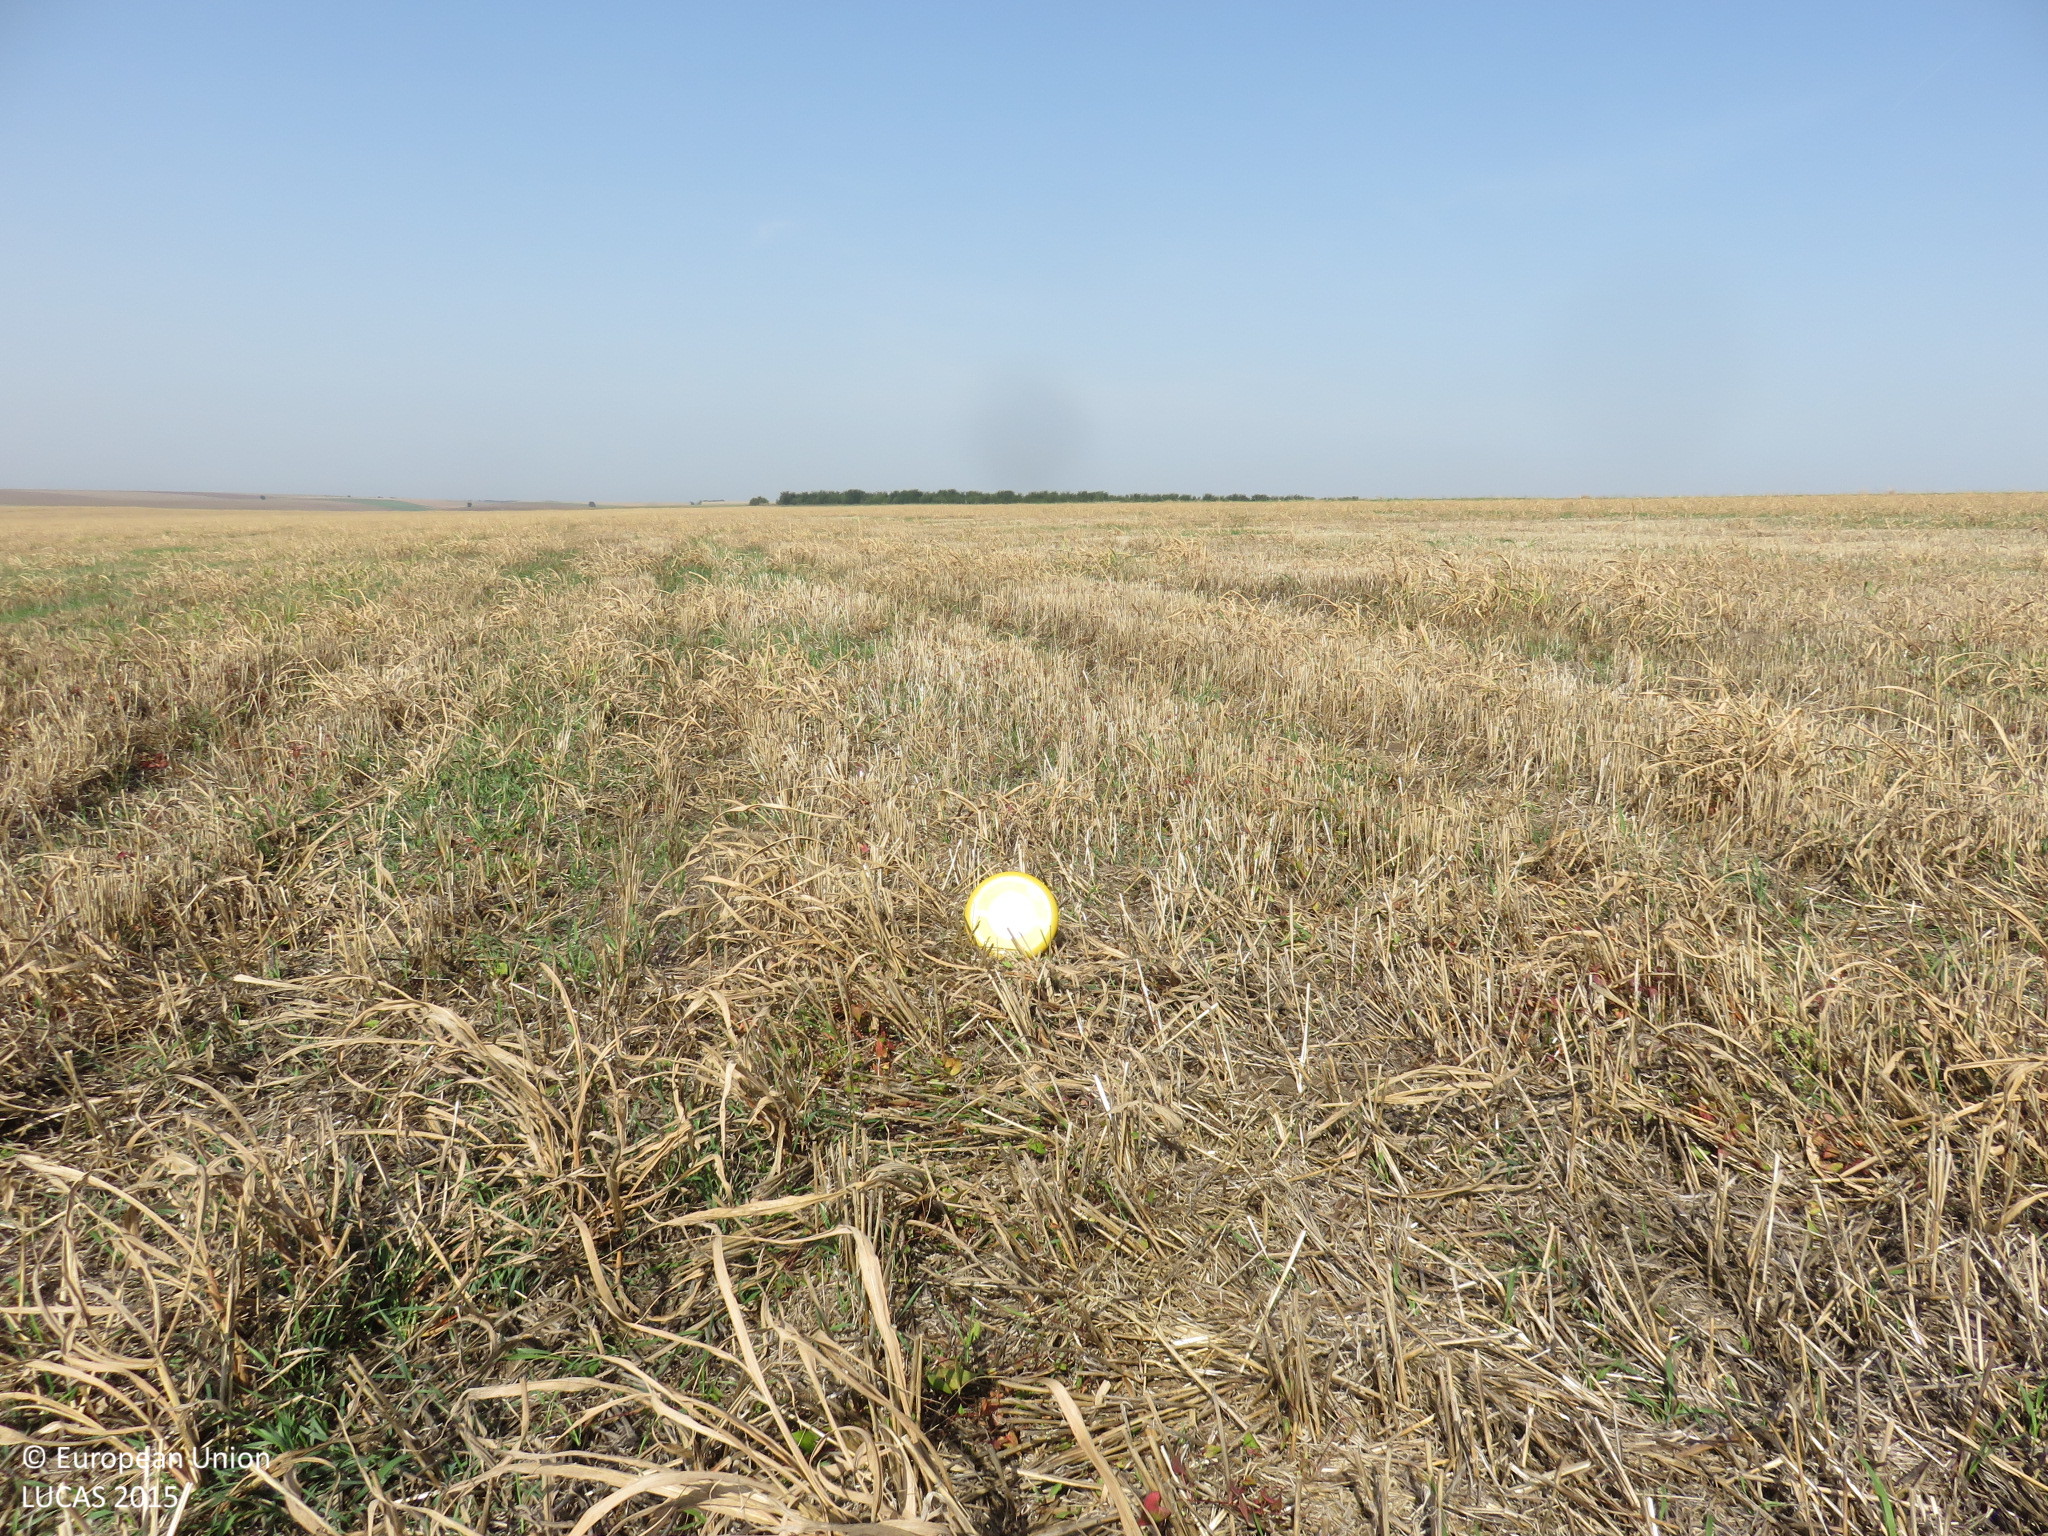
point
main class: Cropland
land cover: Common wheat
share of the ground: > 75 %
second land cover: Spontaneously vegetated surfaces
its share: < 10 %
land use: Agriculture (excluding fallow land and kitchen gardens)
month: September
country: BG
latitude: 43.5941
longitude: 24.5435
